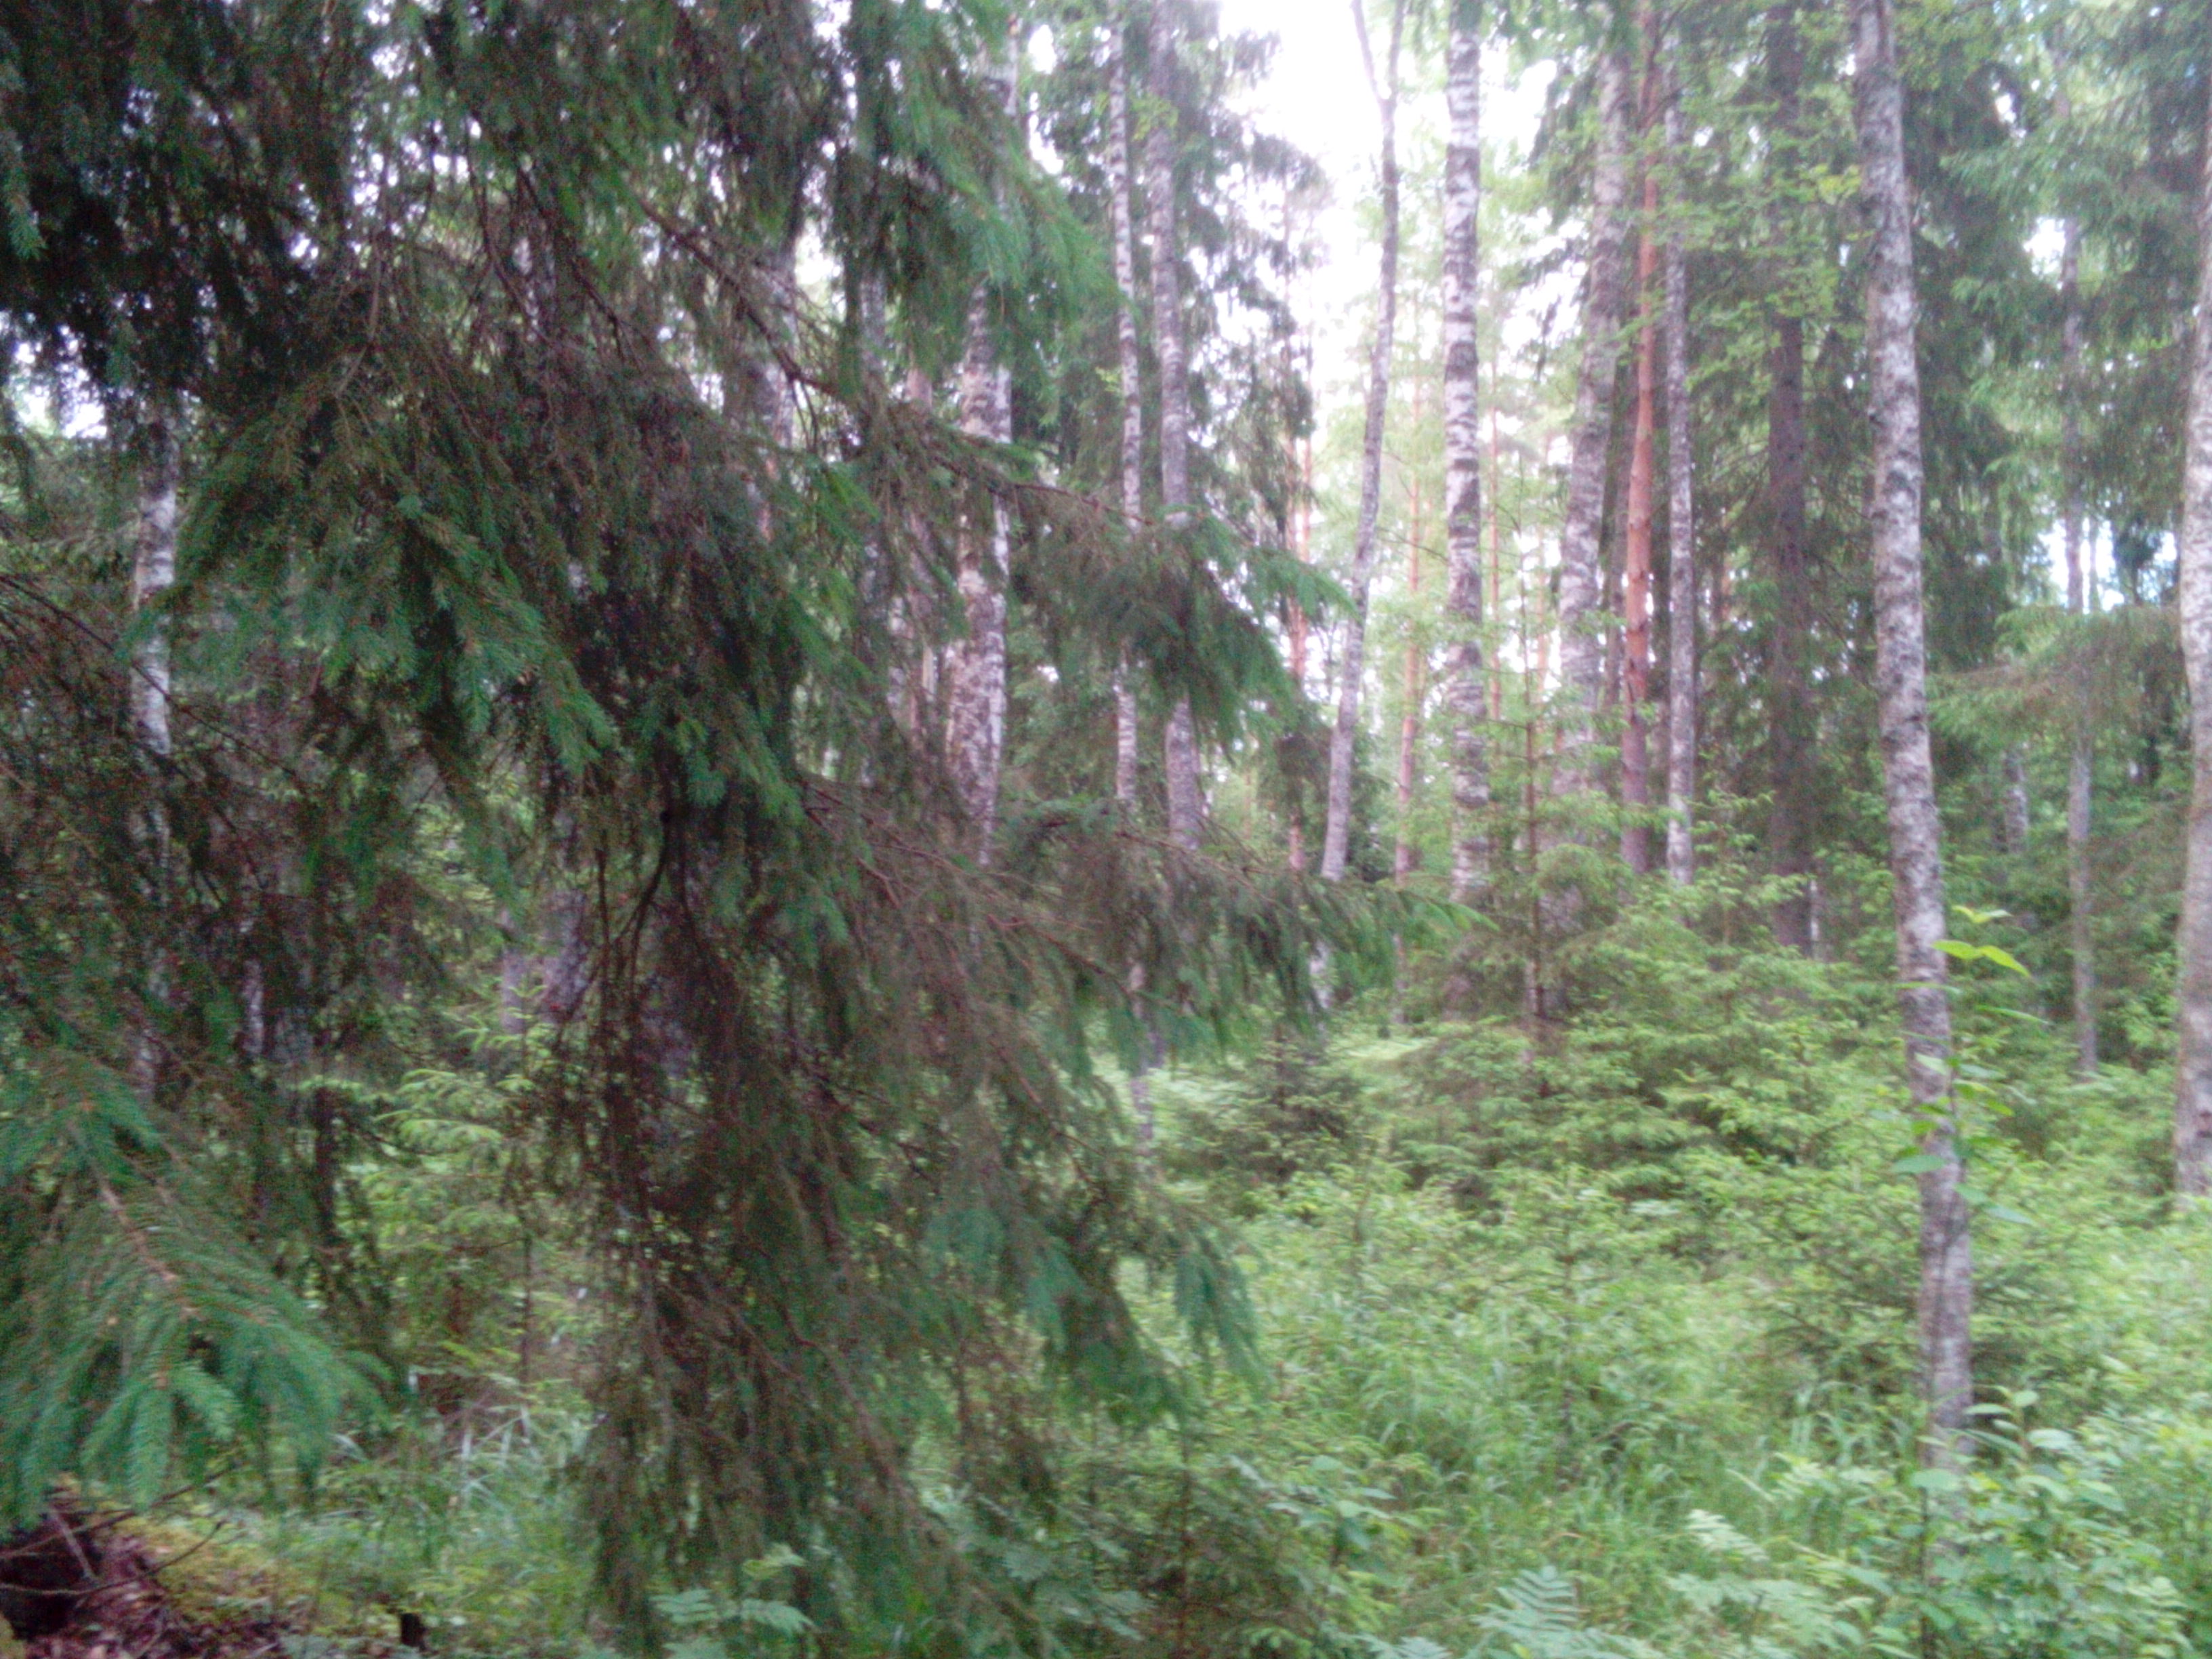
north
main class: Woodland
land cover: Other mixed woodland
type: hemiboreal forest and nemoral coniferous forest and mixed broadleaved-coniferous forest
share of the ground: > 75 %
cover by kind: coniferous forest trees 50 %, broadleaved forest trees 25 %, herbaceous plants 20 %, shrubs 5 %
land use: Forestry
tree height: > 5 m
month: June
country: LV
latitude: 56.9980
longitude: 21.4809
